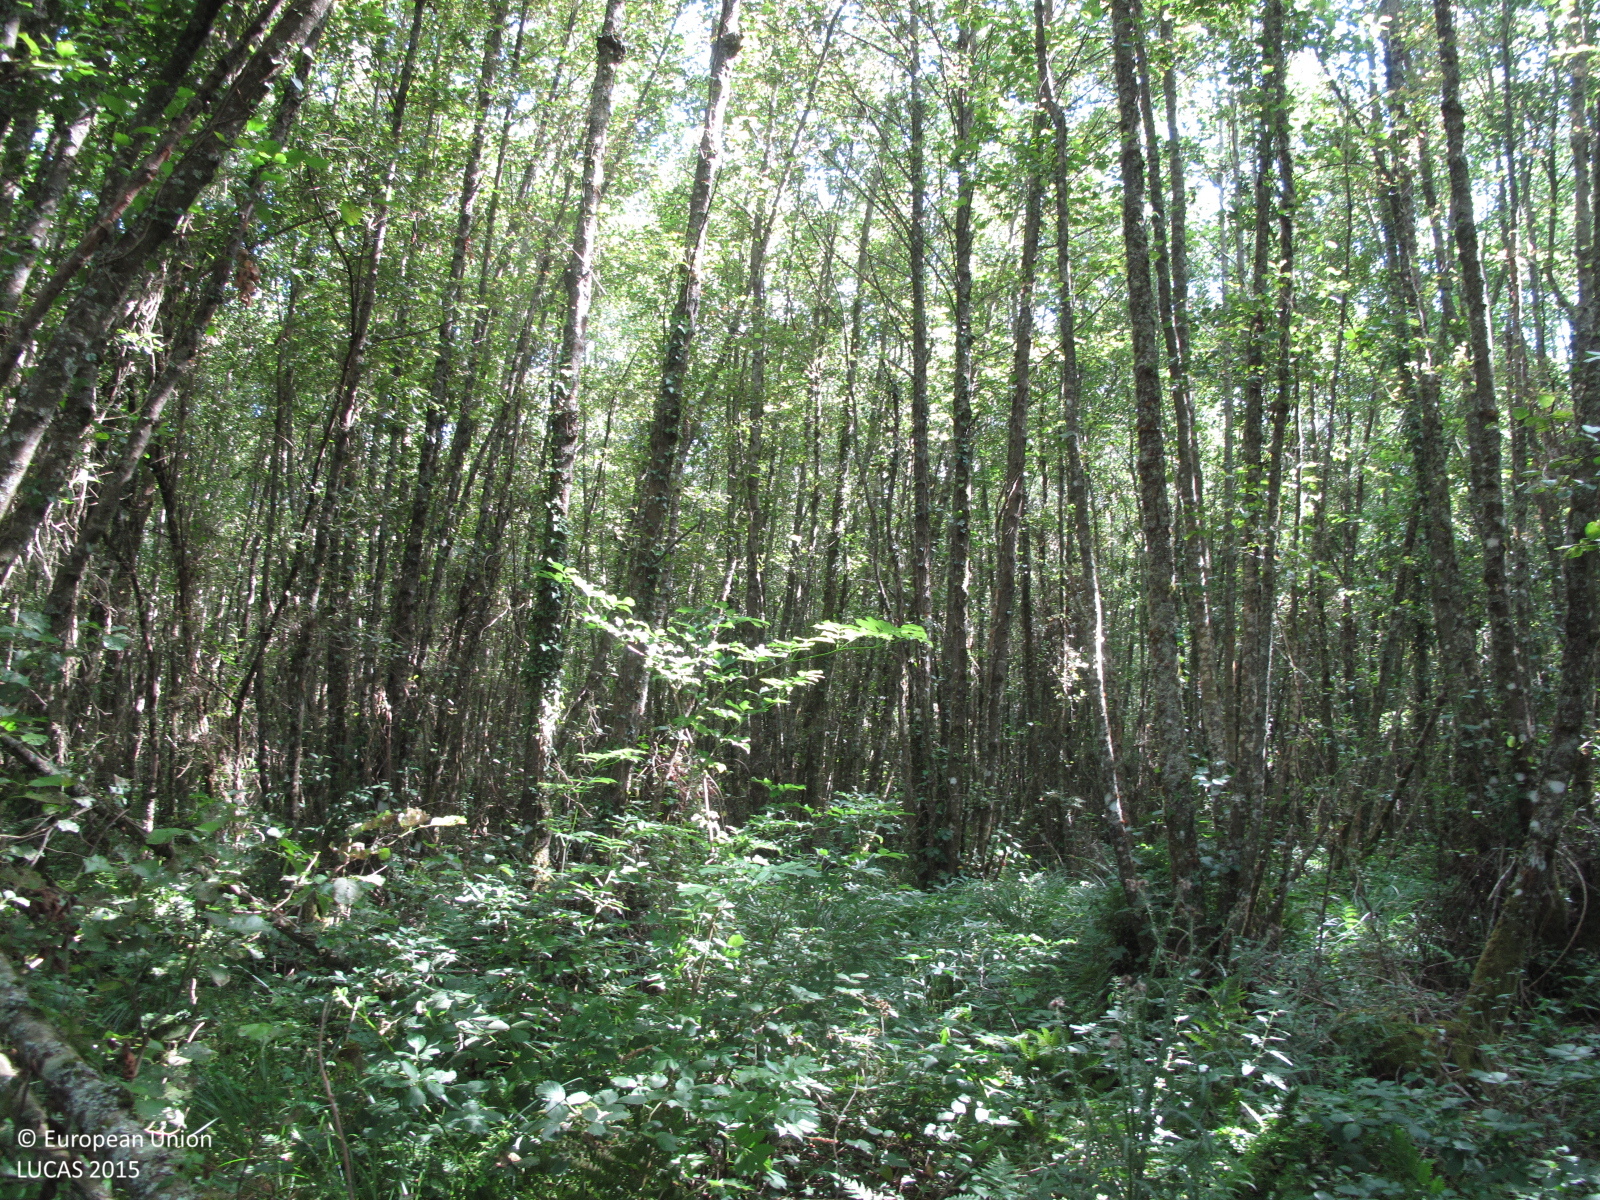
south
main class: Woodland
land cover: Broadleaved woodland
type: floodplain forest
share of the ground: > 75 %
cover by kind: broadleaved forest trees 90 %, shrubs 5 %, herbaceous plants 5 %
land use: Semi-natural and natural areas not in use
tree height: > 5 m
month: July
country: ES
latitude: 43.0592
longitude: -7.9798
